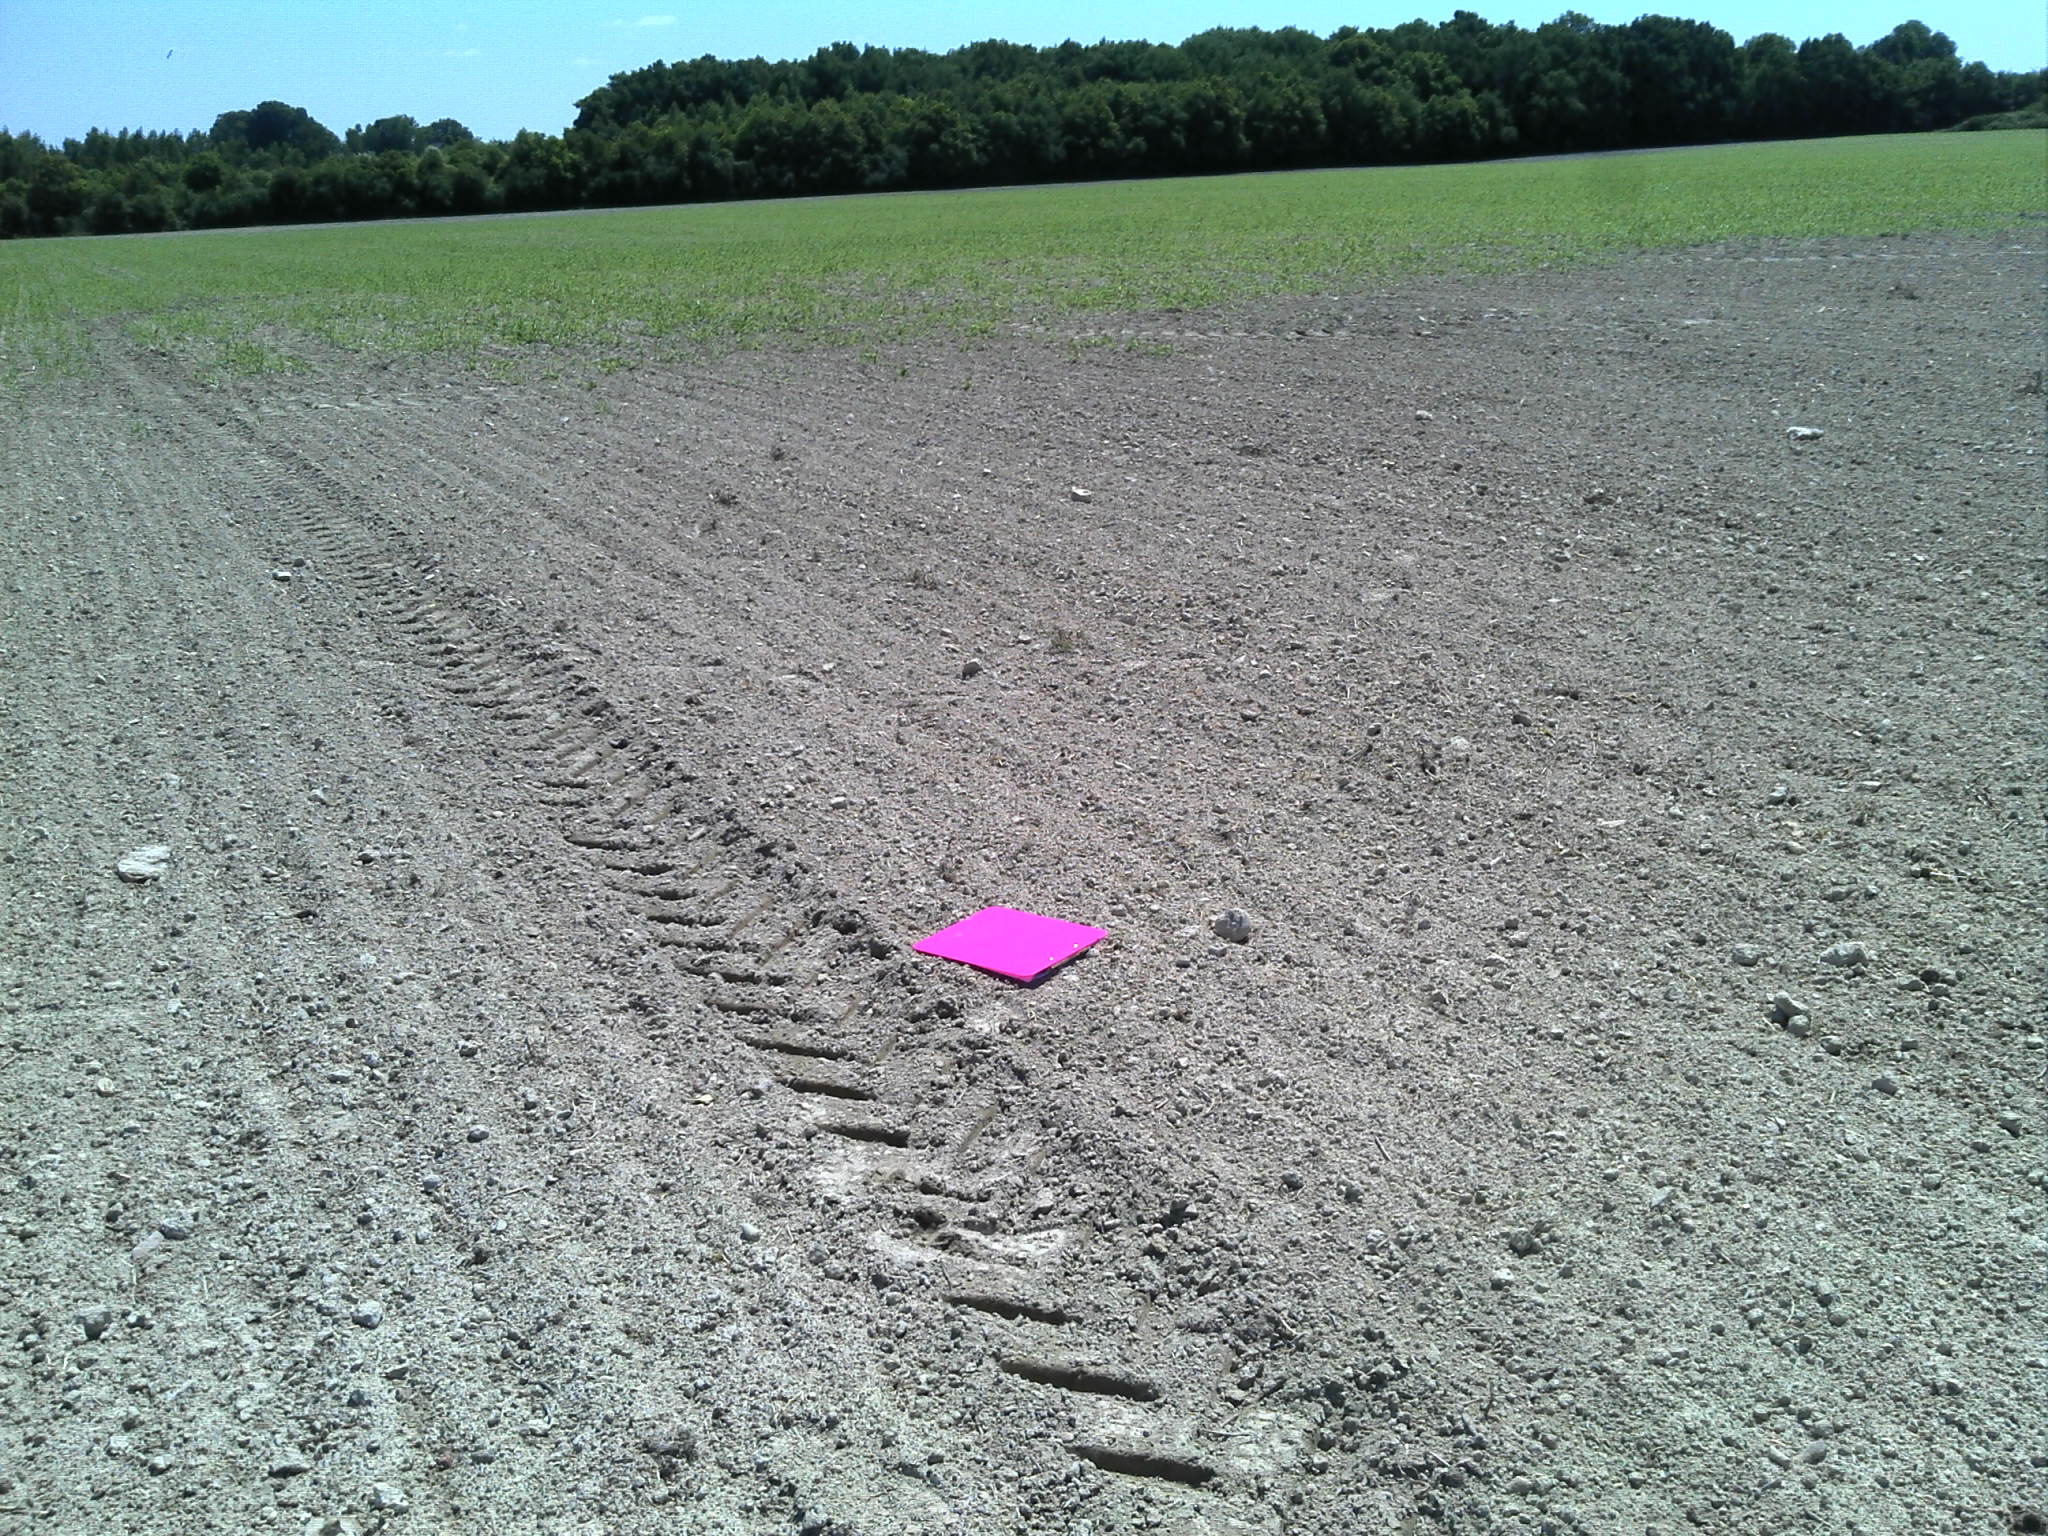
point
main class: Cropland
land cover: Maize
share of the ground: < 10 %
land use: Agriculture (excluding fallow land and kitchen gardens)
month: June
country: FR
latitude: 47.1451
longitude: 1.4021
